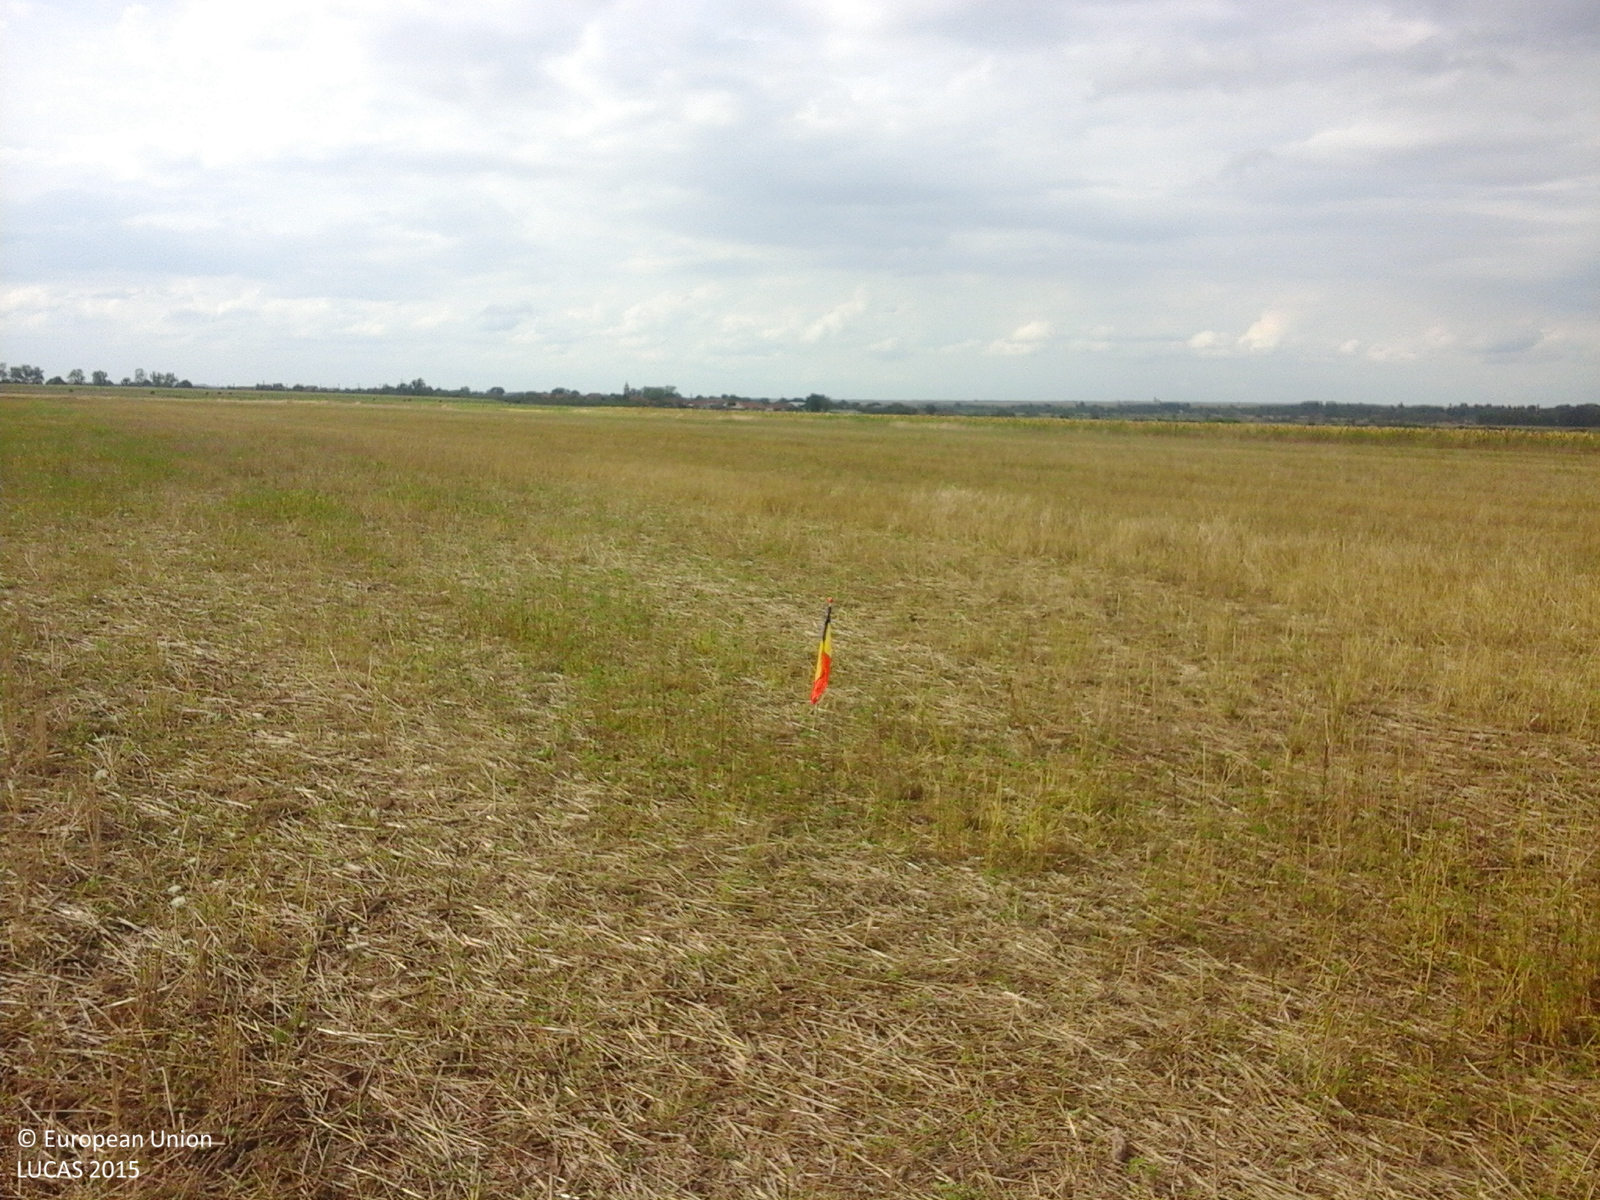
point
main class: Cropland
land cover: Common wheat
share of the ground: 25 - 50 %
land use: Agriculture (excluding fallow land and kitchen gardens)
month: August
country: RO
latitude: 45.5239
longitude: 21.5429
